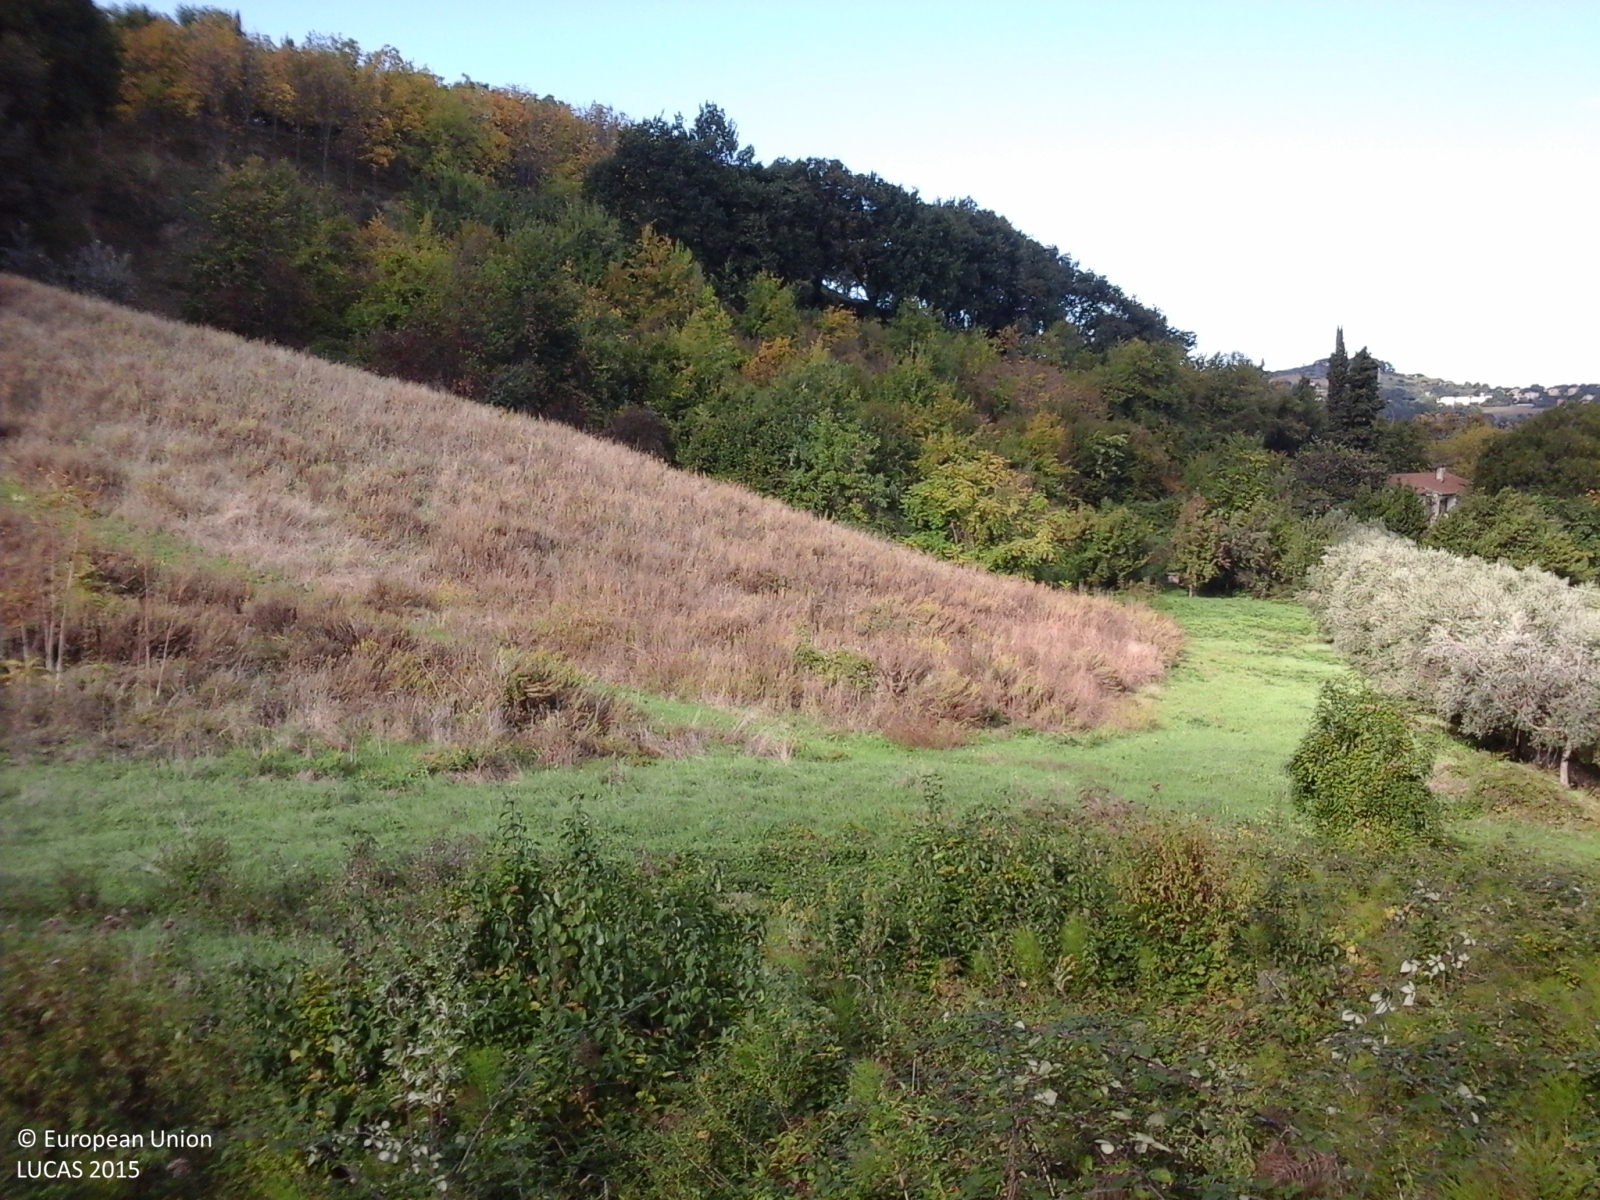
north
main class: Woodland
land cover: Broadleaved woodland
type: thermophilous deciduous forest
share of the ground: > 75 %
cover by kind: broadleaved forest trees 100 %
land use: Semi-natural and natural areas not in use
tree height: > 5 m
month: October
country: IT
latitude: 43.5522
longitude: 13.4699
